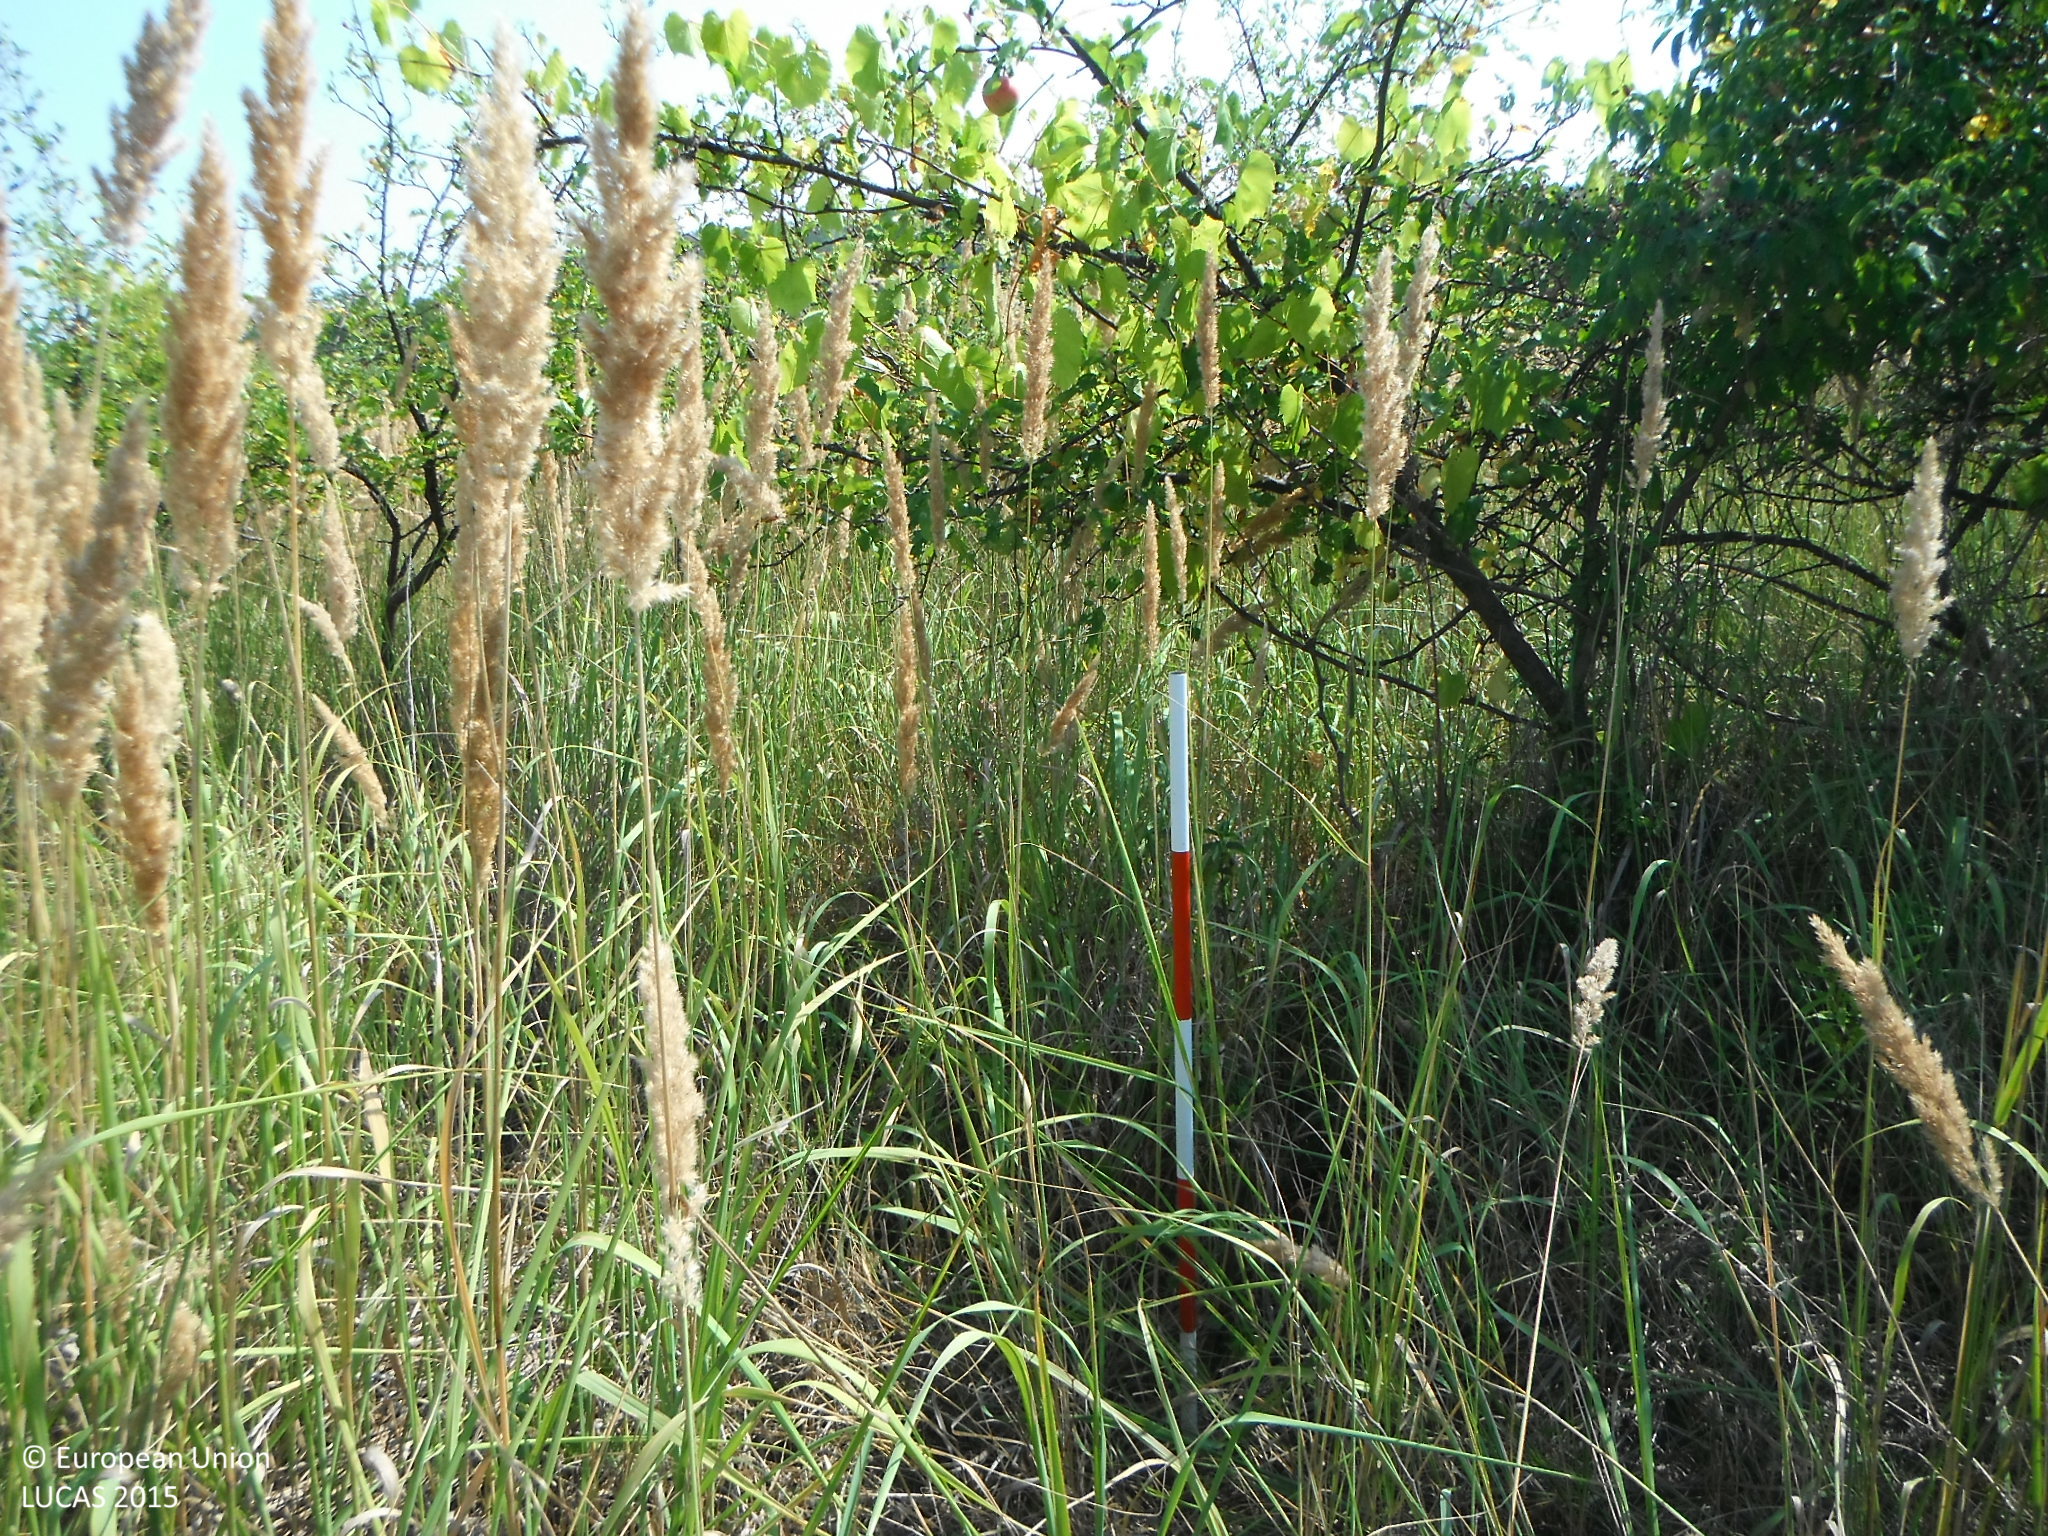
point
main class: Cropland
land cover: Apple fruit
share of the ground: 50 - 75 %
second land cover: Spontaneously vegetated surfaces
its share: > 75 %
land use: Abandoned areas
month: August
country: SK
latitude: 48.4247
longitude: 21.9587
